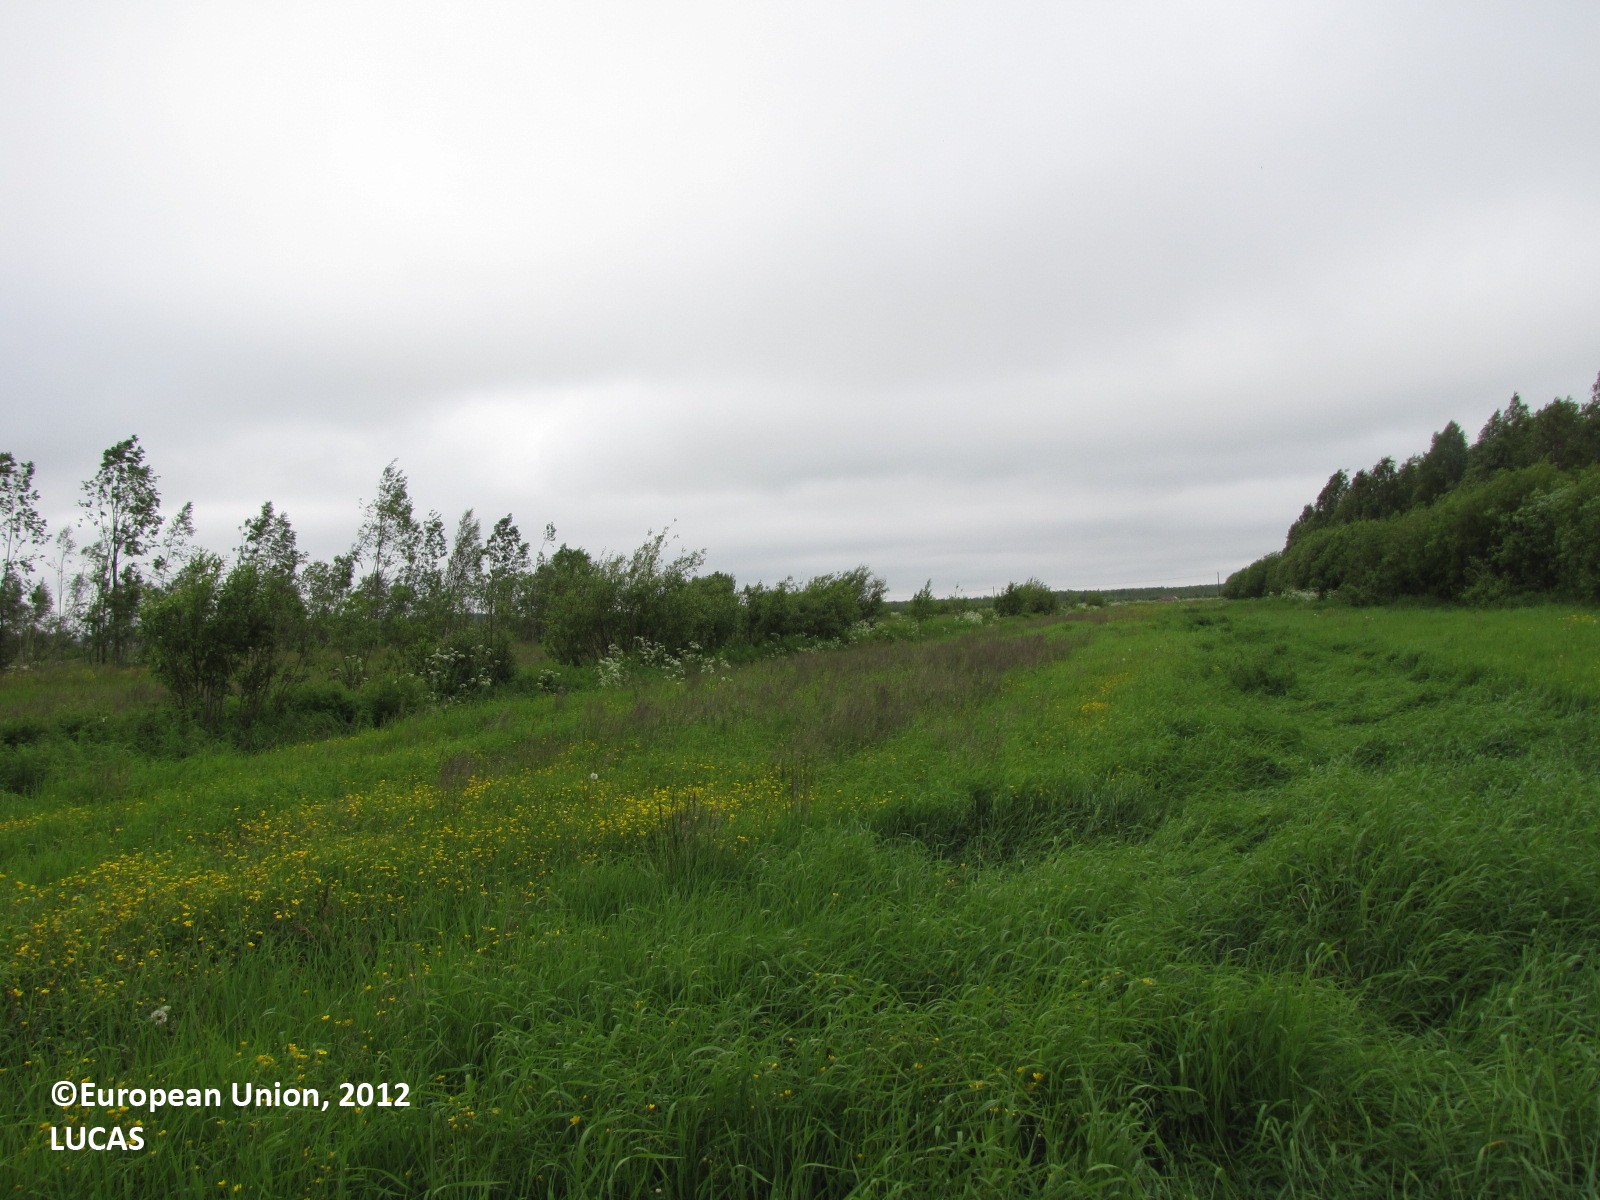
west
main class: Grassland
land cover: Grassland without tree/shrub cover
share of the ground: > 75 %
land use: Agriculture (excluding fallow land and kitchen gardens)
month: July
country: FI
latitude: 66.1077
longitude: 24.4984
